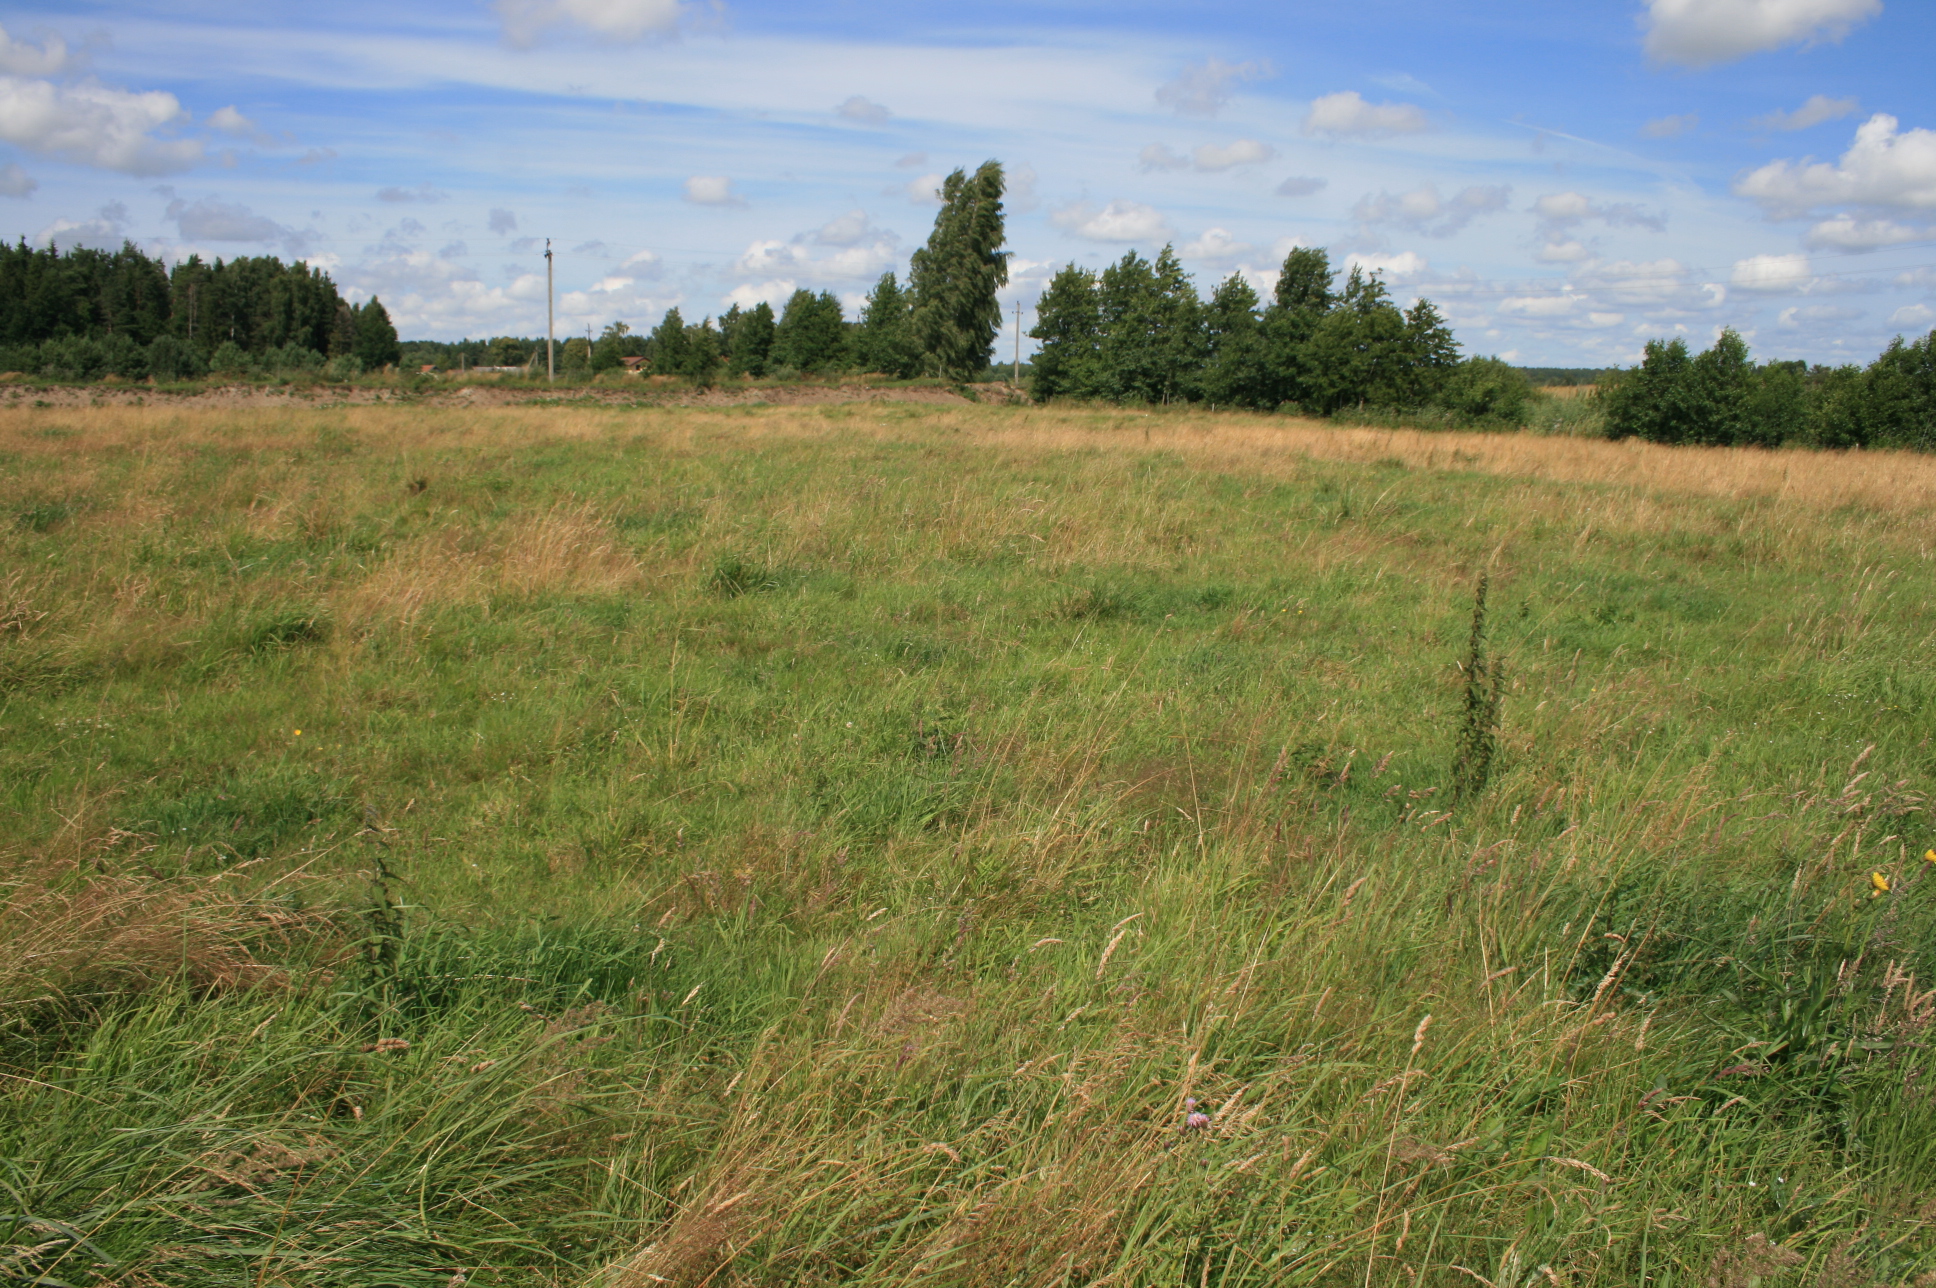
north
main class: Grassland
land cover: Grassland without tree/shrub cover
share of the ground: > 75 %
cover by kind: herbaceous plants 100 %
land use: Agriculture (excluding fallow land and kitchen gardens)
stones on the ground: < 10 %
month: July
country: LT
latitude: 55.5433
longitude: 21.2790
